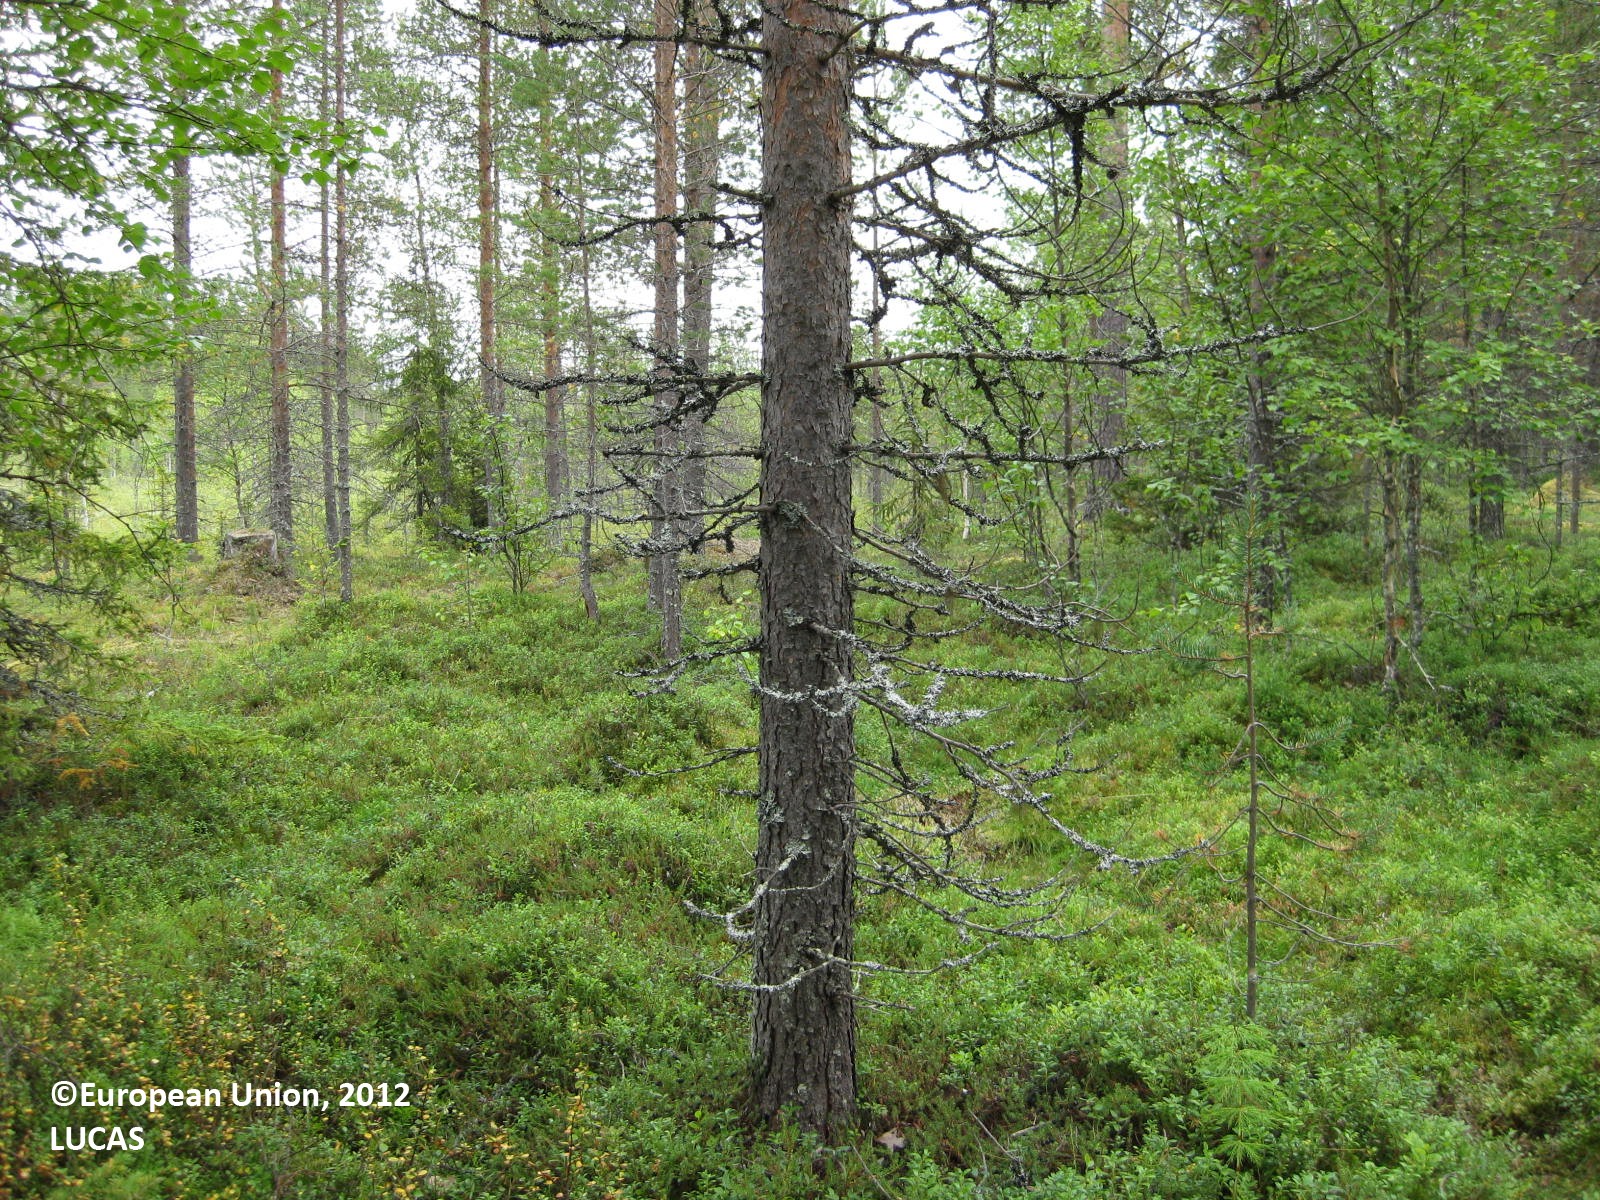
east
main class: Woodland
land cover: Pine dominated coniferous woodland
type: boreal forest
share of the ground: 50 - 75 %
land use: Forestry
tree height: > 5 m
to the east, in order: Pine dominated coniferous woodland; Ditches and canals; Pine dominated mixed woodland; Broadleaved woodland; Pine dominated mixed woodland; Pine dominated coniferous woodland; Peatbogs
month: August
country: FI
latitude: 66.4741
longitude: 28.9998
